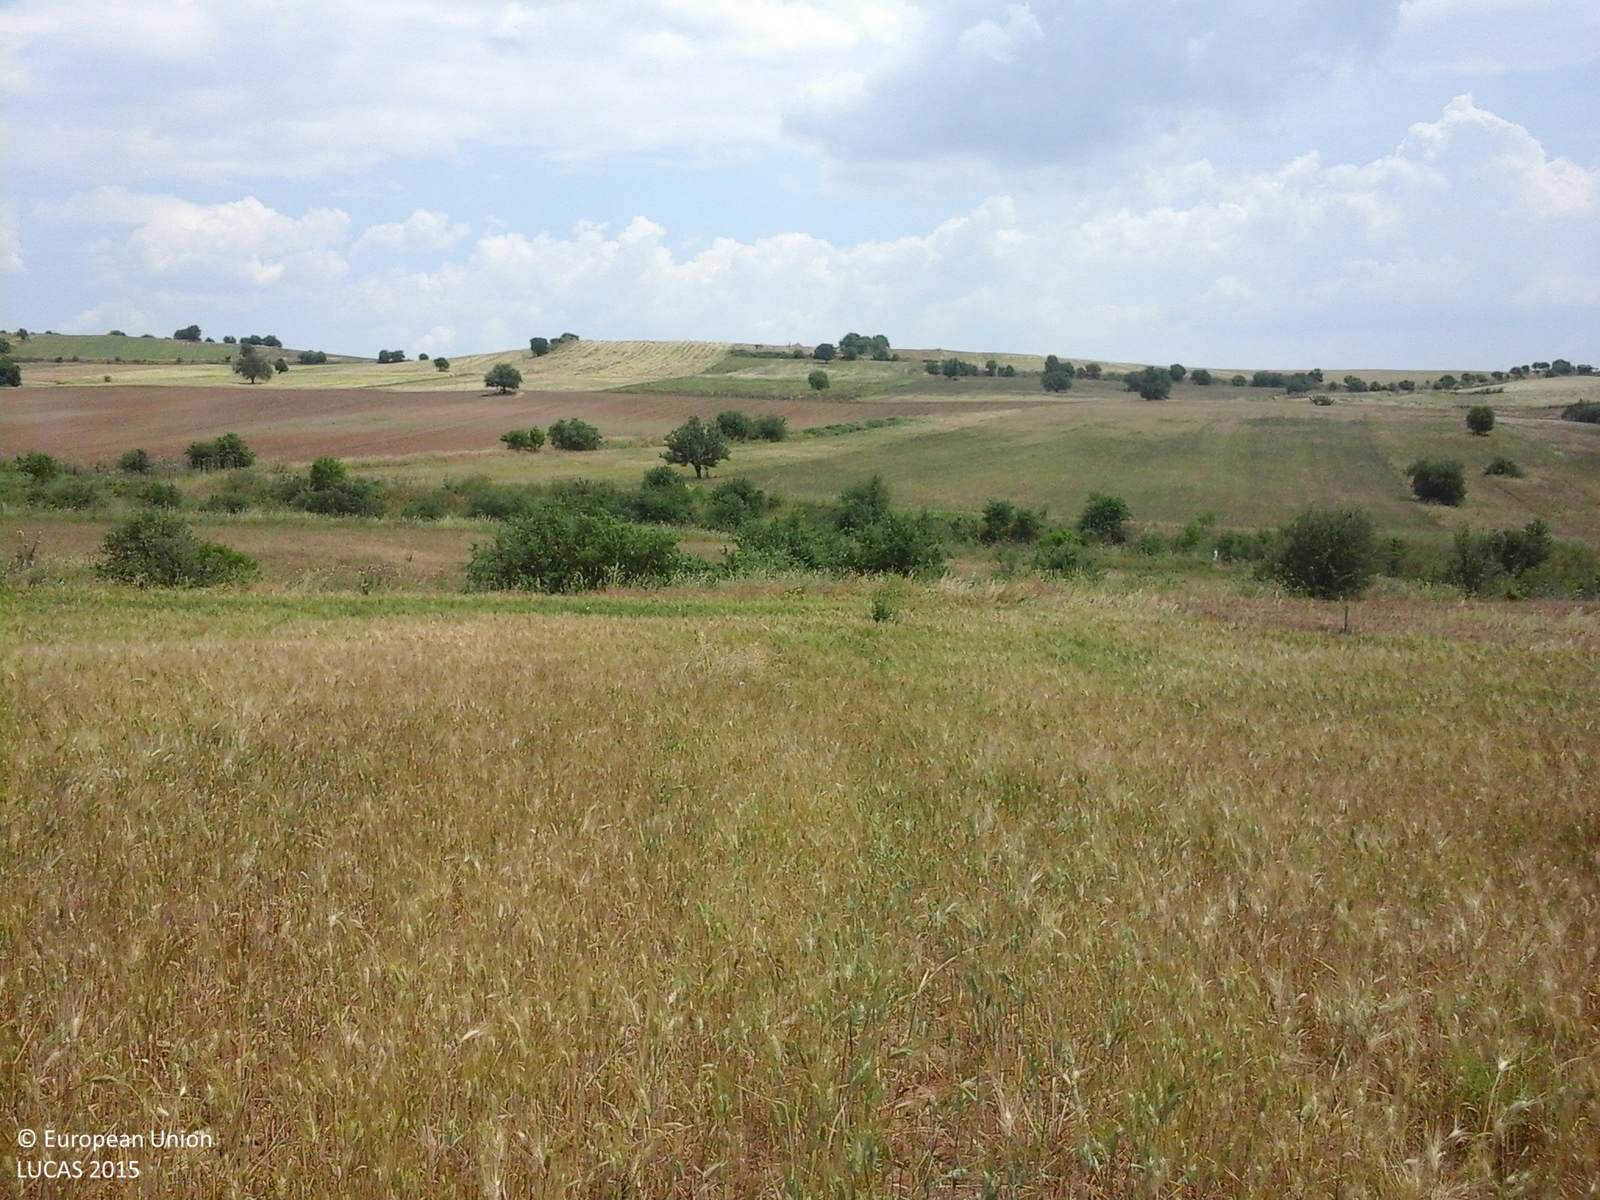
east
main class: Cropland
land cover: Common wheat
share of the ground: > 75 %
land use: Agriculture (excluding fallow land and kitchen gardens)
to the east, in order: Common wheat; Shrubland without tree cover; Common wheat; Shrubland without tree cover; Tracks; Shrubland without tree cover; Common wheat; Shruby margins; Other bare soil
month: June
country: GR
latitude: 40.4555
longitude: 22.8931
